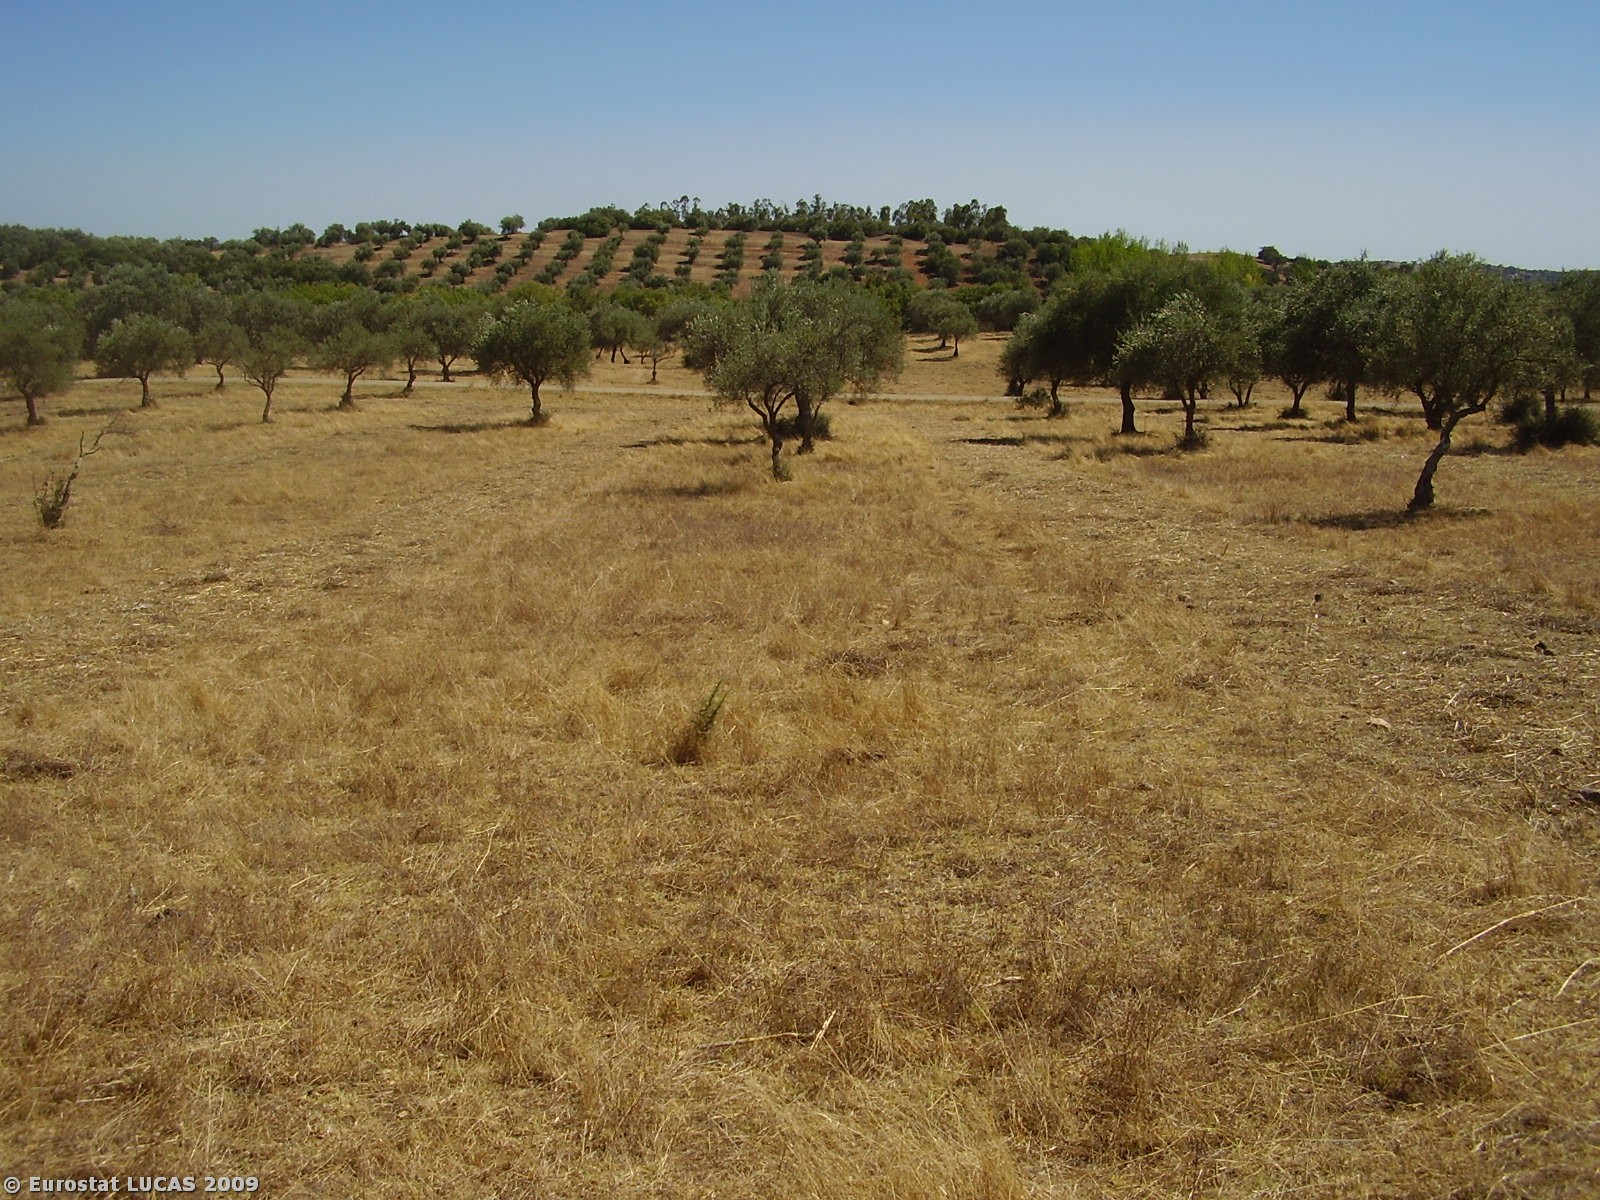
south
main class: Cropland
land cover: Olive groves
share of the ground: 25 - 50 %
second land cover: Spontaneously vegetated surfaces
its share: 25 - 50 %
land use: Agriculture (excluding fallow land and kitchen gardens)
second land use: Fallow land
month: July
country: PT
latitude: 37.8968
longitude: -7.5423
